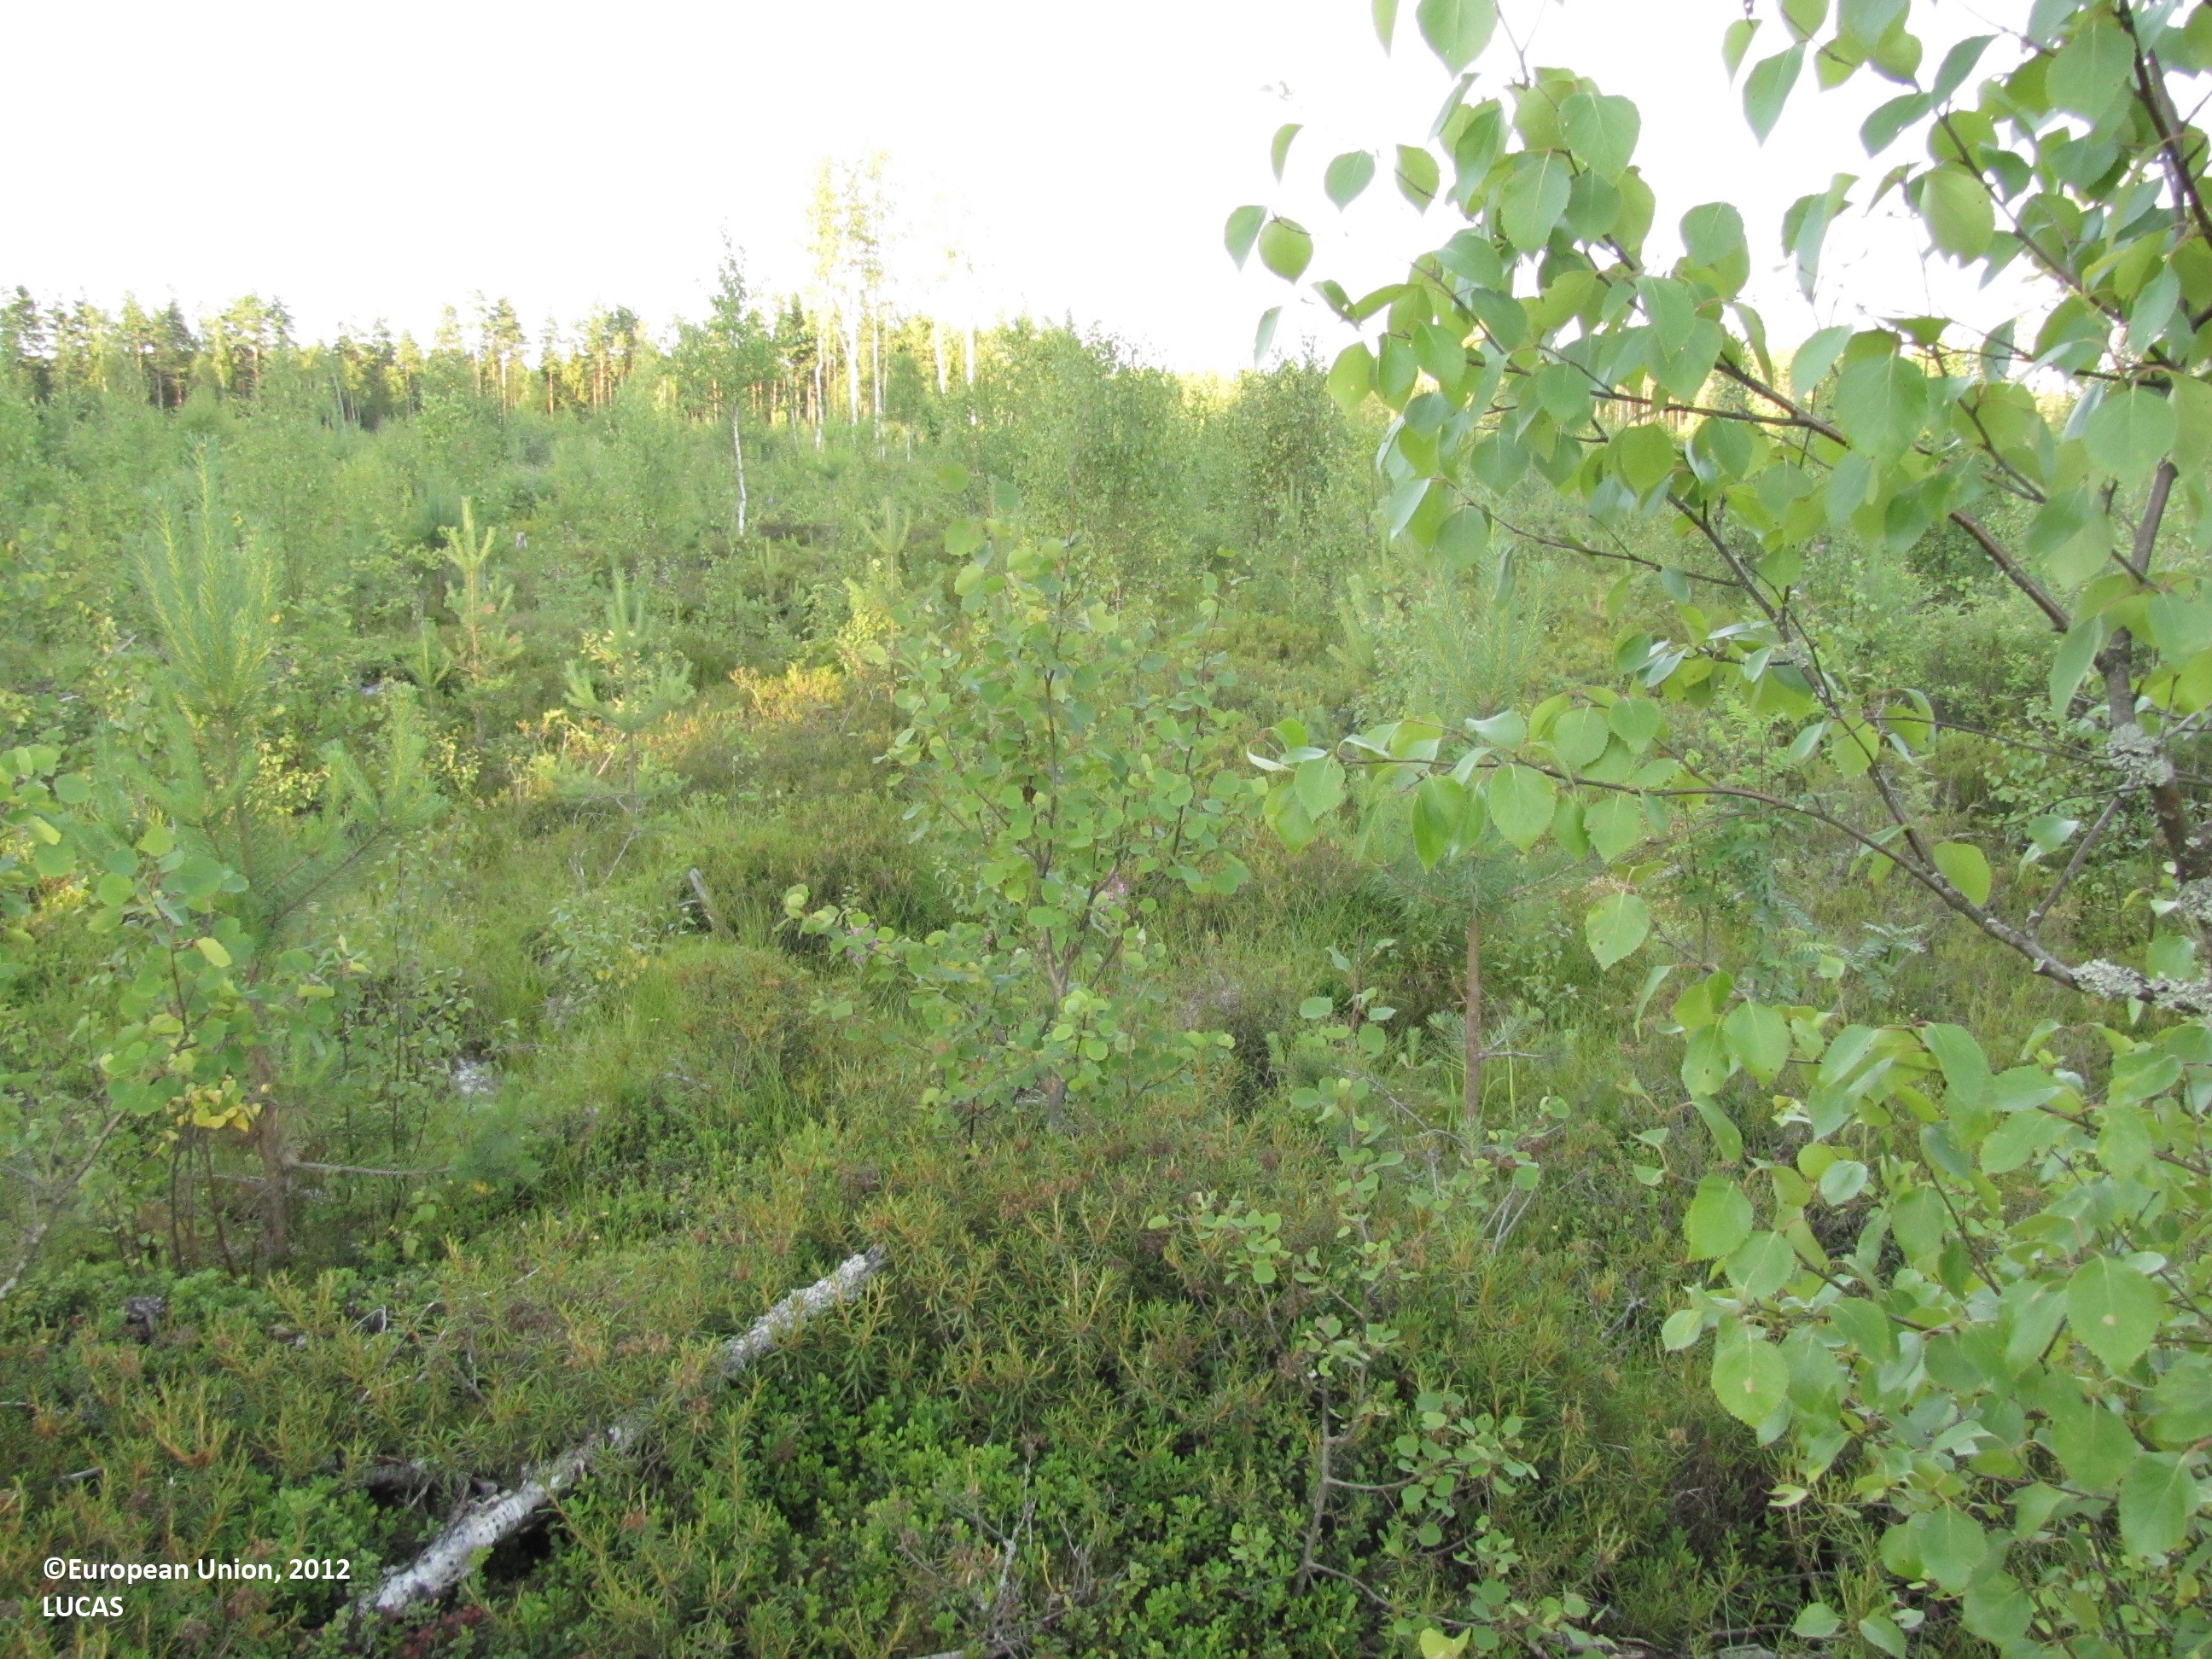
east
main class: Woodland
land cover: Broadleaved woodland
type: mire and swamp forests
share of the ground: 50 - 75 %
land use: Forestry
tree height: < 5 m
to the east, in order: Broadleaved woodland; Ditches and canals; Pine dominated coniferous woodland; Ditches and canals; Pine dominated mixed woodland; Ditches and canals; Pine dominated mixed woodland
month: July
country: FI
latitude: 62.5675
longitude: 23.3174
